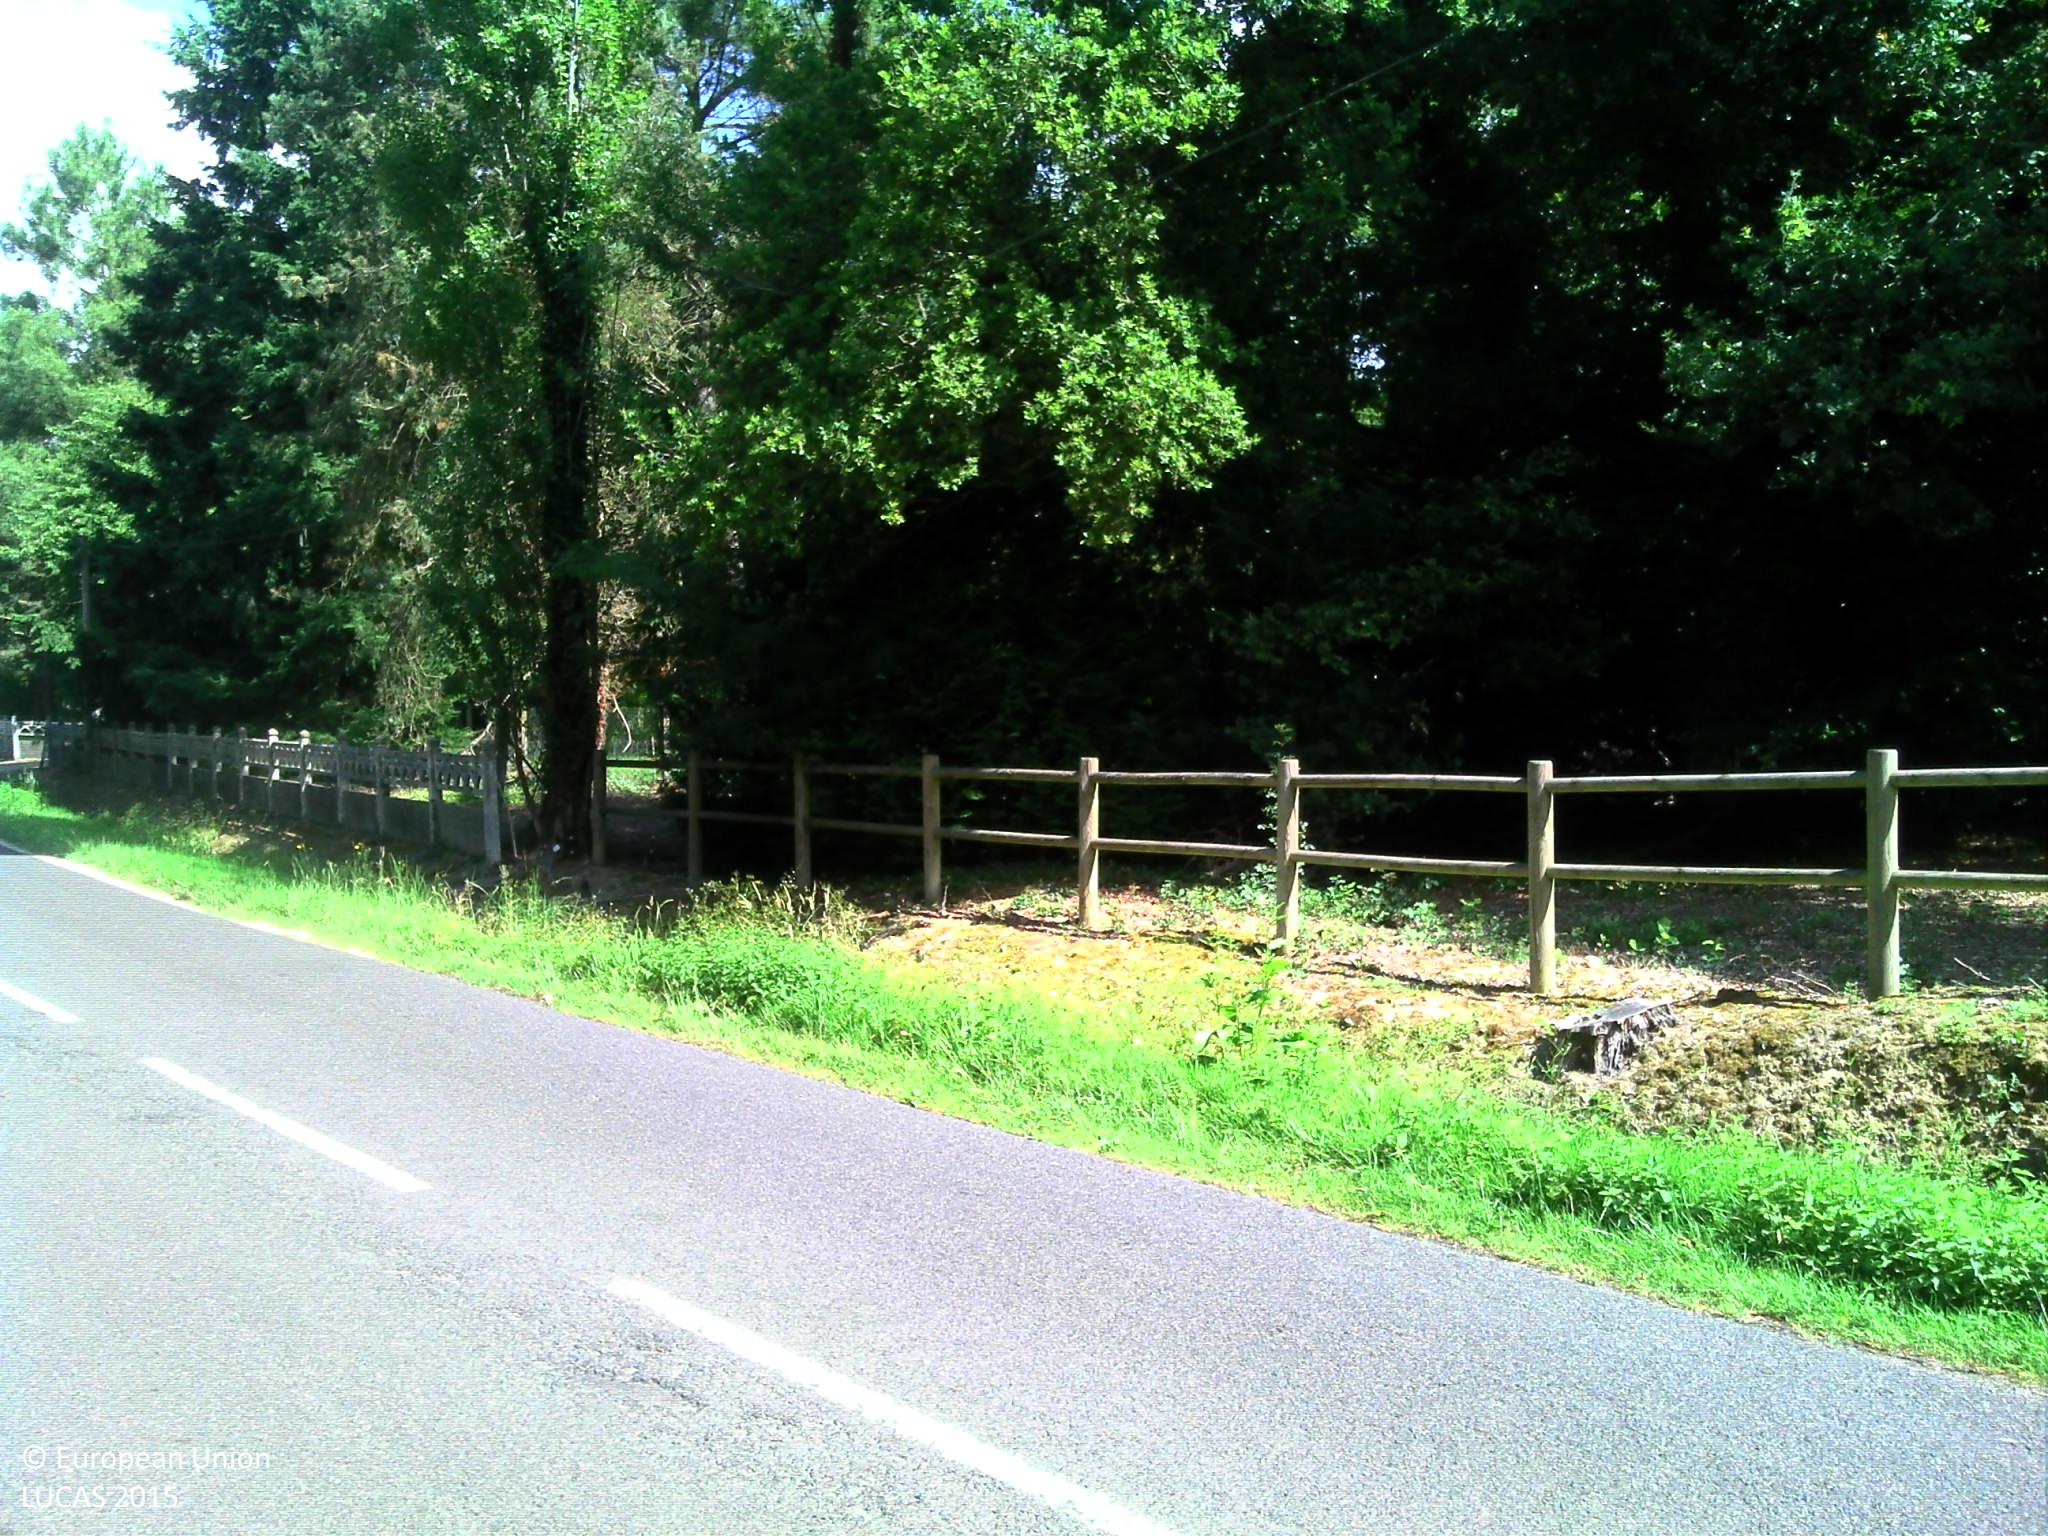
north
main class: Woodland
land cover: Broadleaved woodland
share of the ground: > 75 %
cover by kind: broadleaved forest trees 90 %, shrubs 5 %, herbaceous plants 5 %
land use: Semi-natural and natural areas not in use
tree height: > 5 m
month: June
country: FR
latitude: 47.4761
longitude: 0.3840
